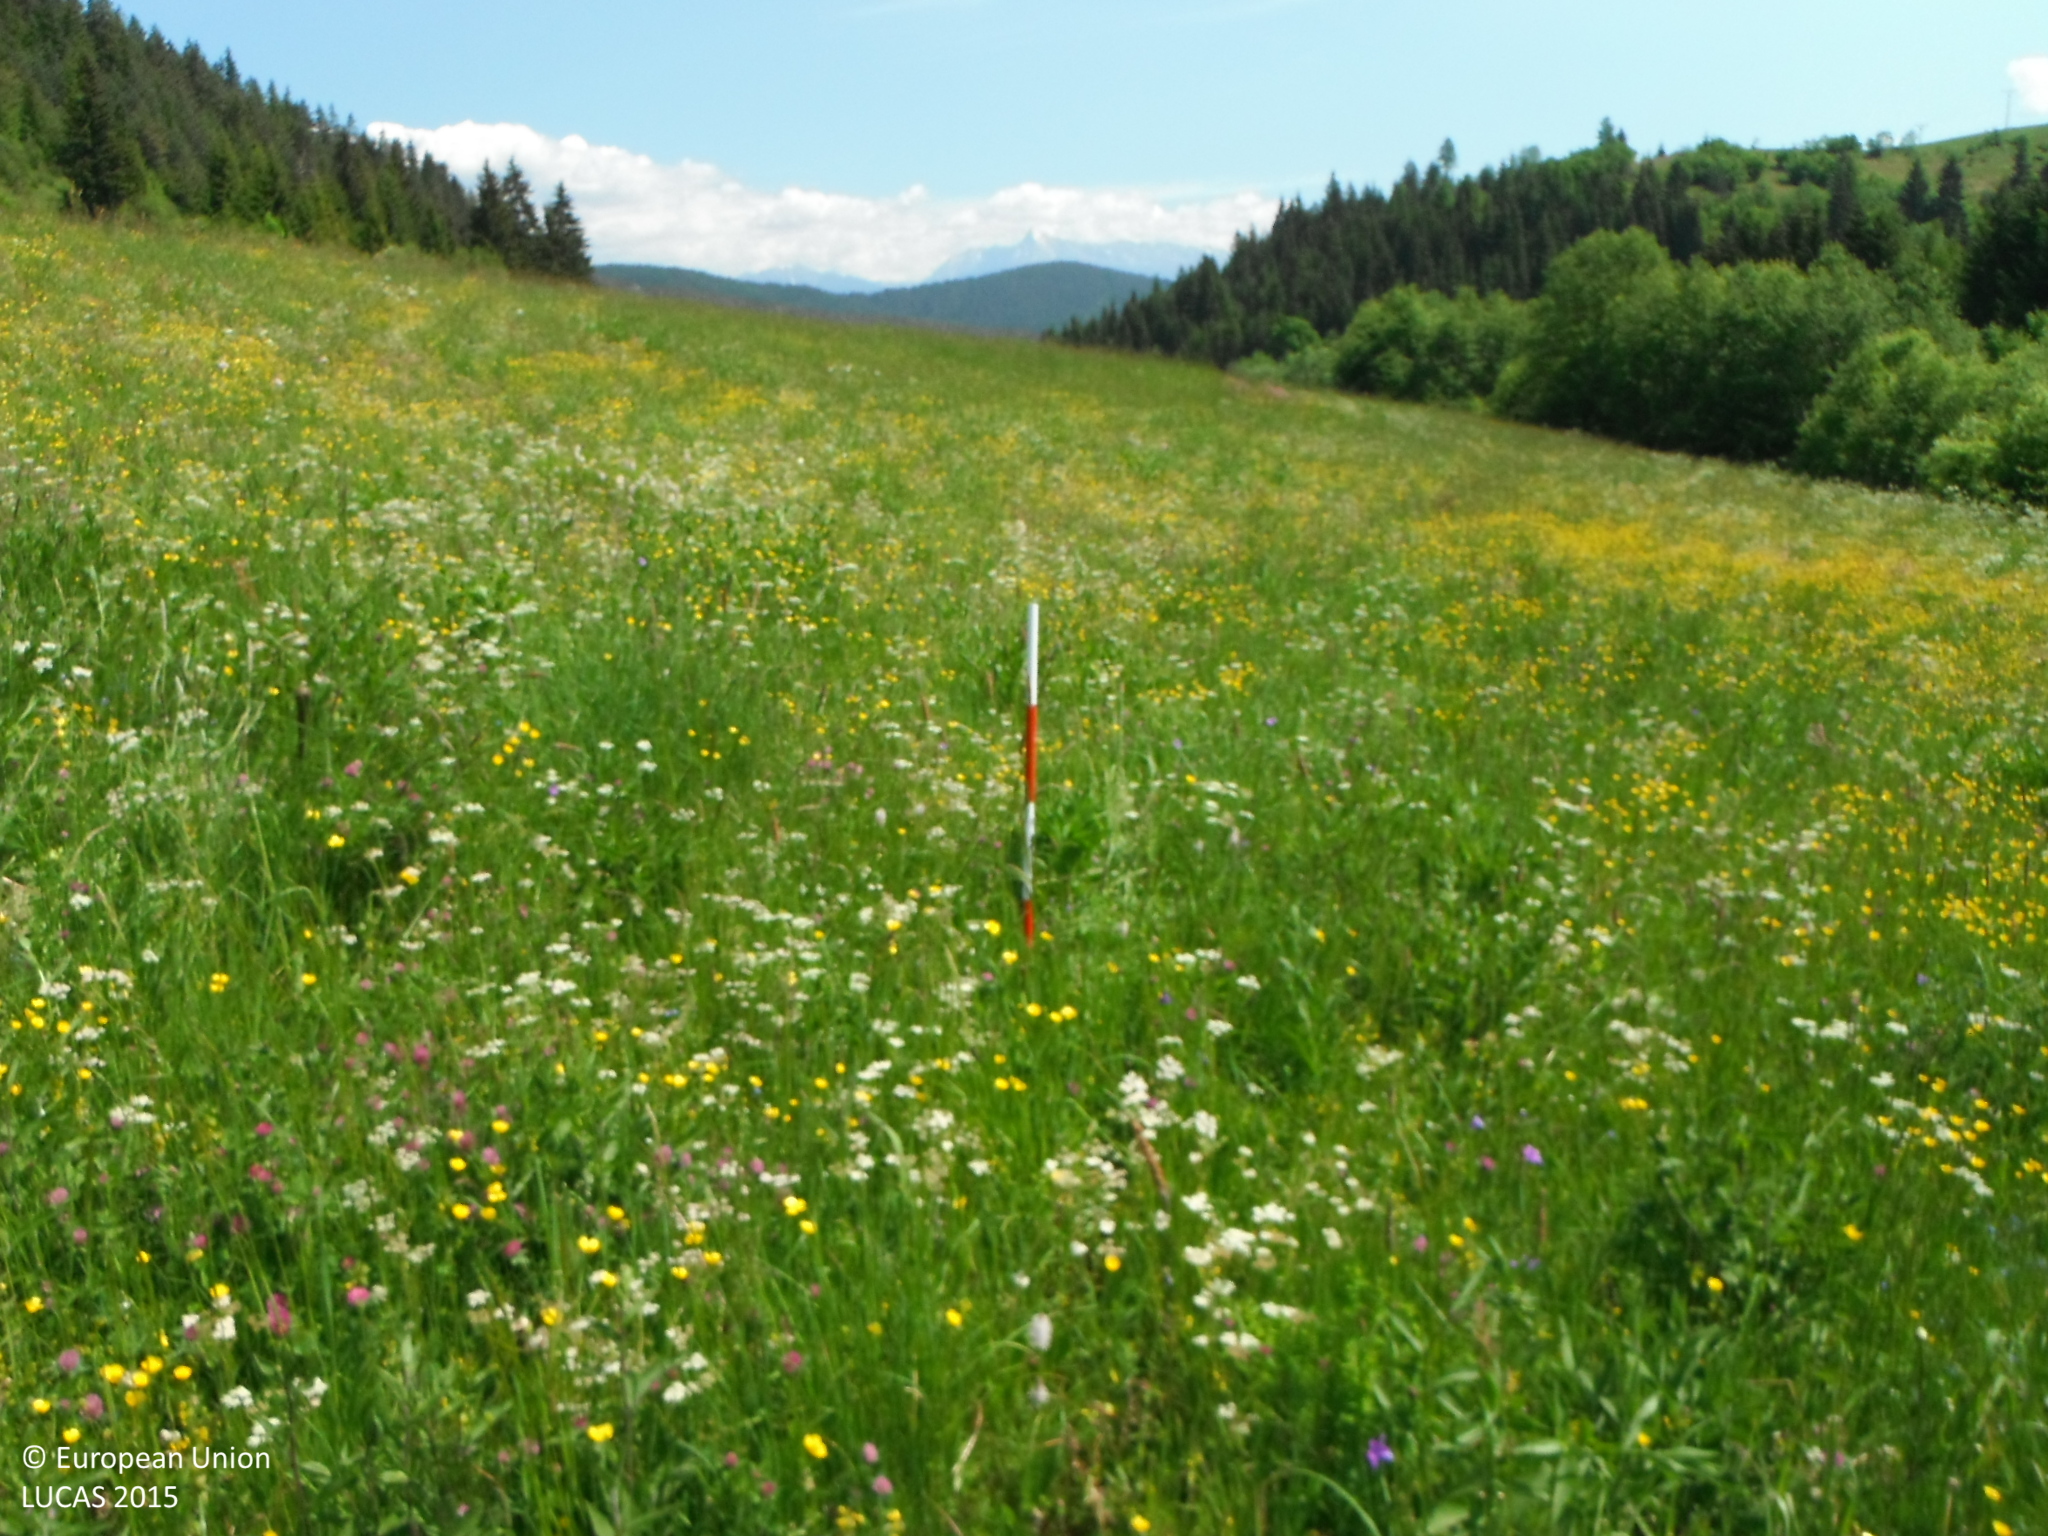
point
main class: Grassland
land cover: Grassland without tree/shrub cover
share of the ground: > 75 %
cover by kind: herbaceous plants 100 %
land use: Agriculture (excluding fallow land and kitchen gardens)
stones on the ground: > 50 %
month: June
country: SK
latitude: 49.0249
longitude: 19.7241
